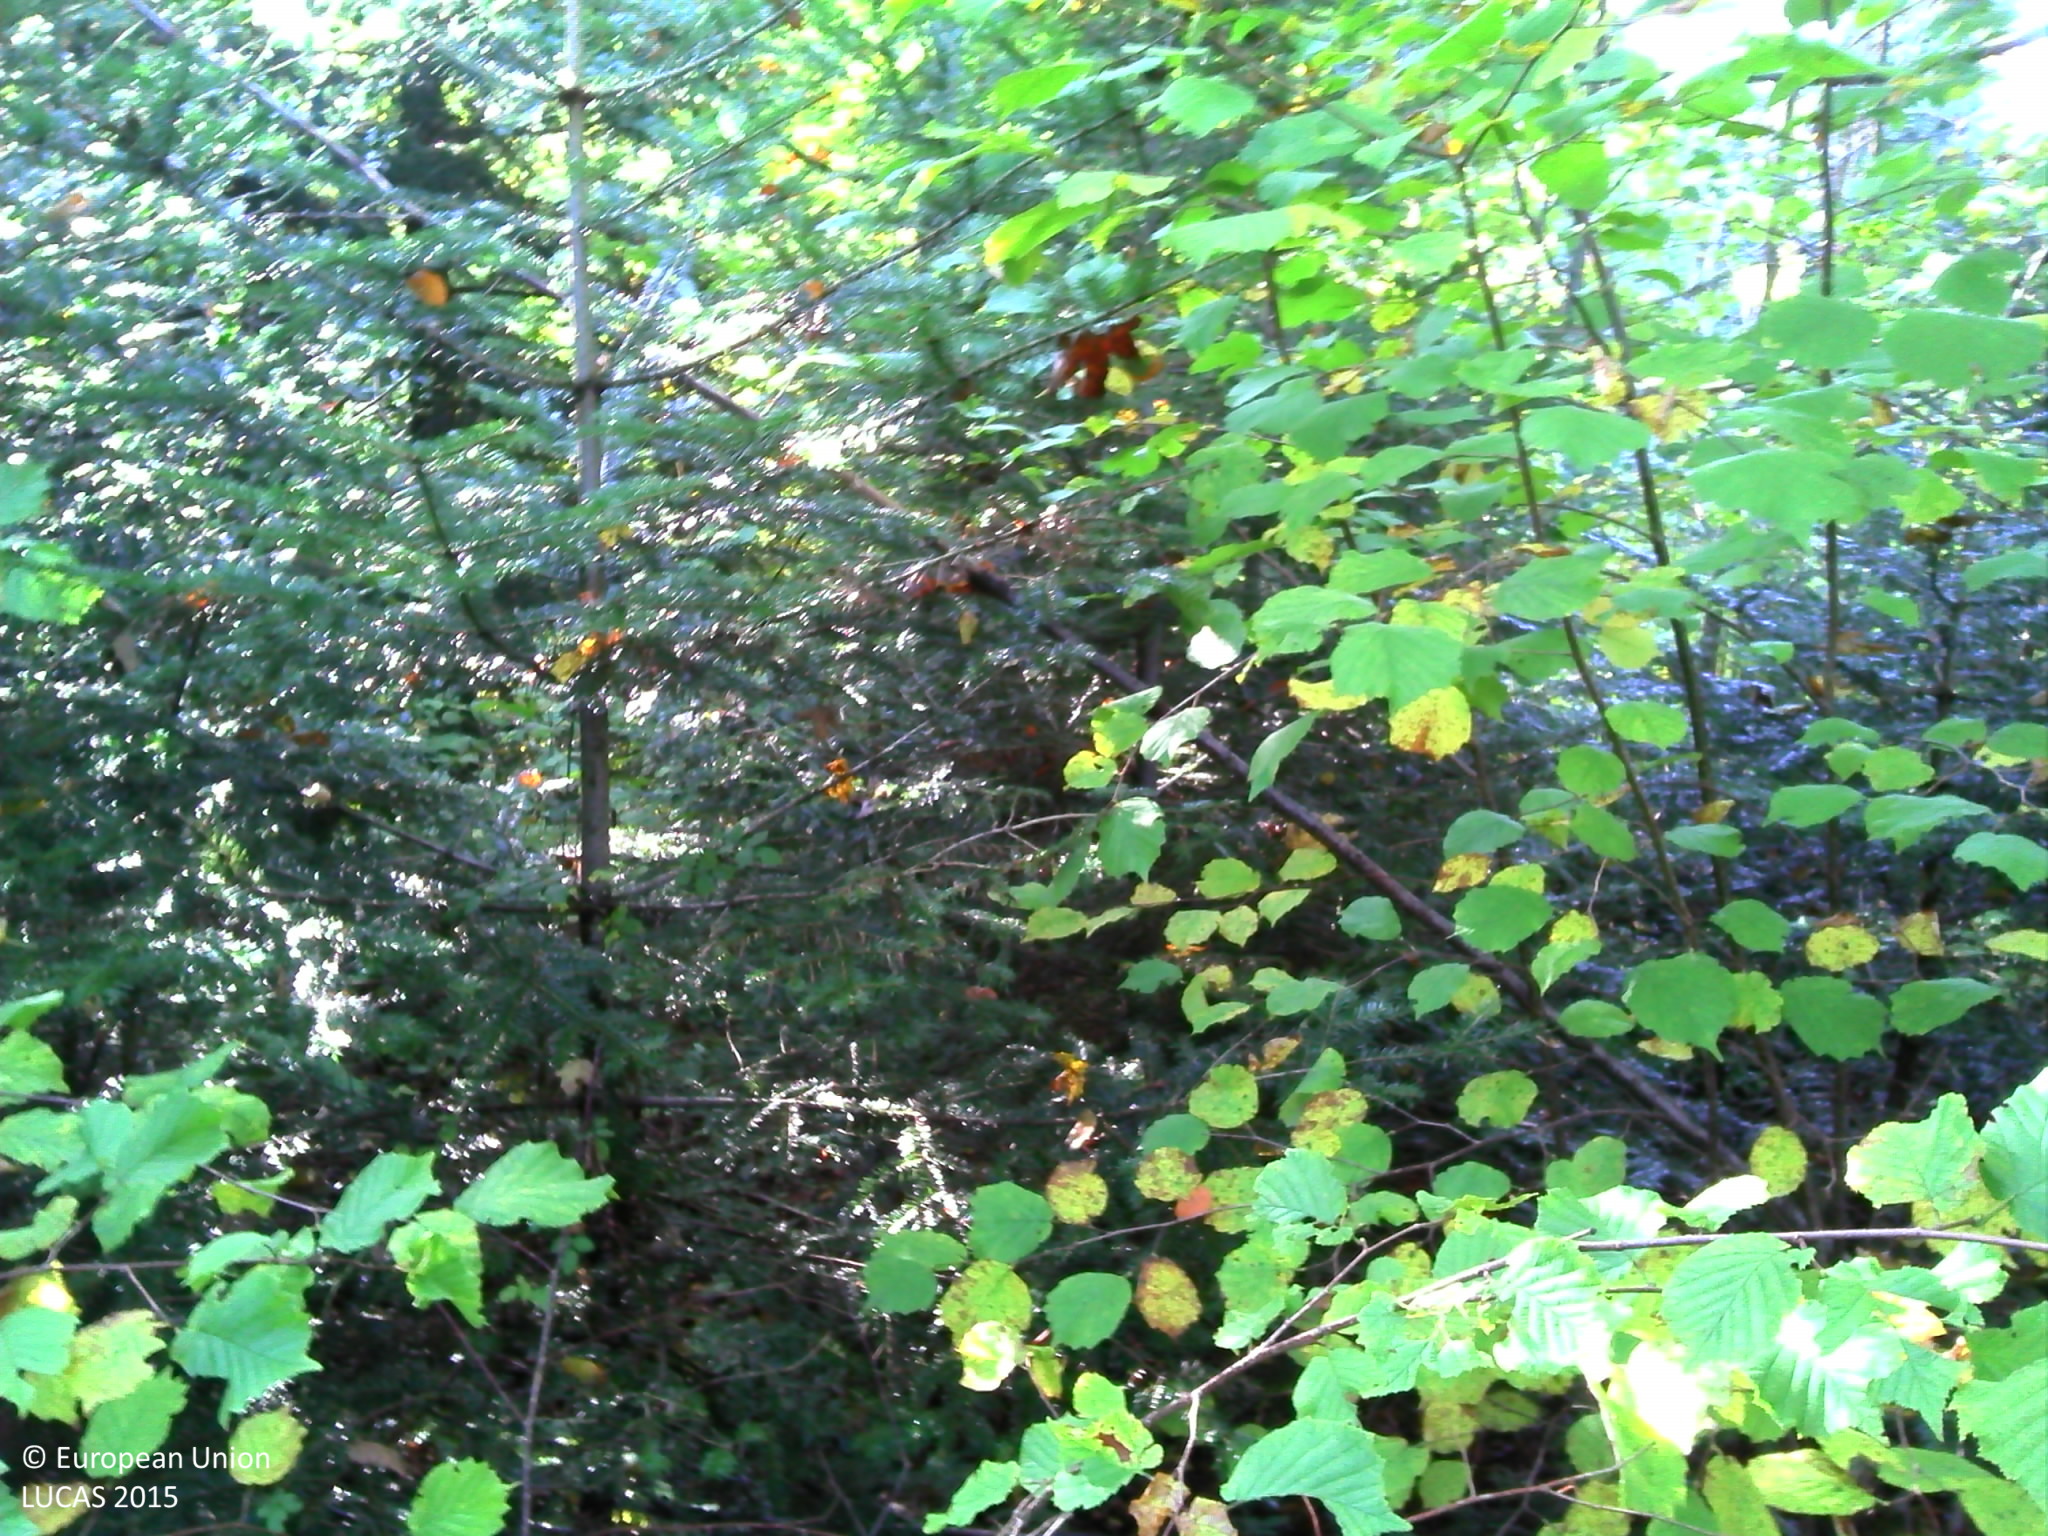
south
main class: Woodland
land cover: Spruce dominated mixed woodland
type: hemiboreal forest and nemoral coniferous forest and mixed broadleaved-coniferous forest
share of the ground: 50 - 75 %
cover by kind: coniferous forest trees 40 %, broadleaved forest trees 30 %, shrubs 20 %, herbaceous plants 10 %
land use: Forestry
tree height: > 5 m
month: October
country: FR
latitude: 47.0813
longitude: 6.3274
